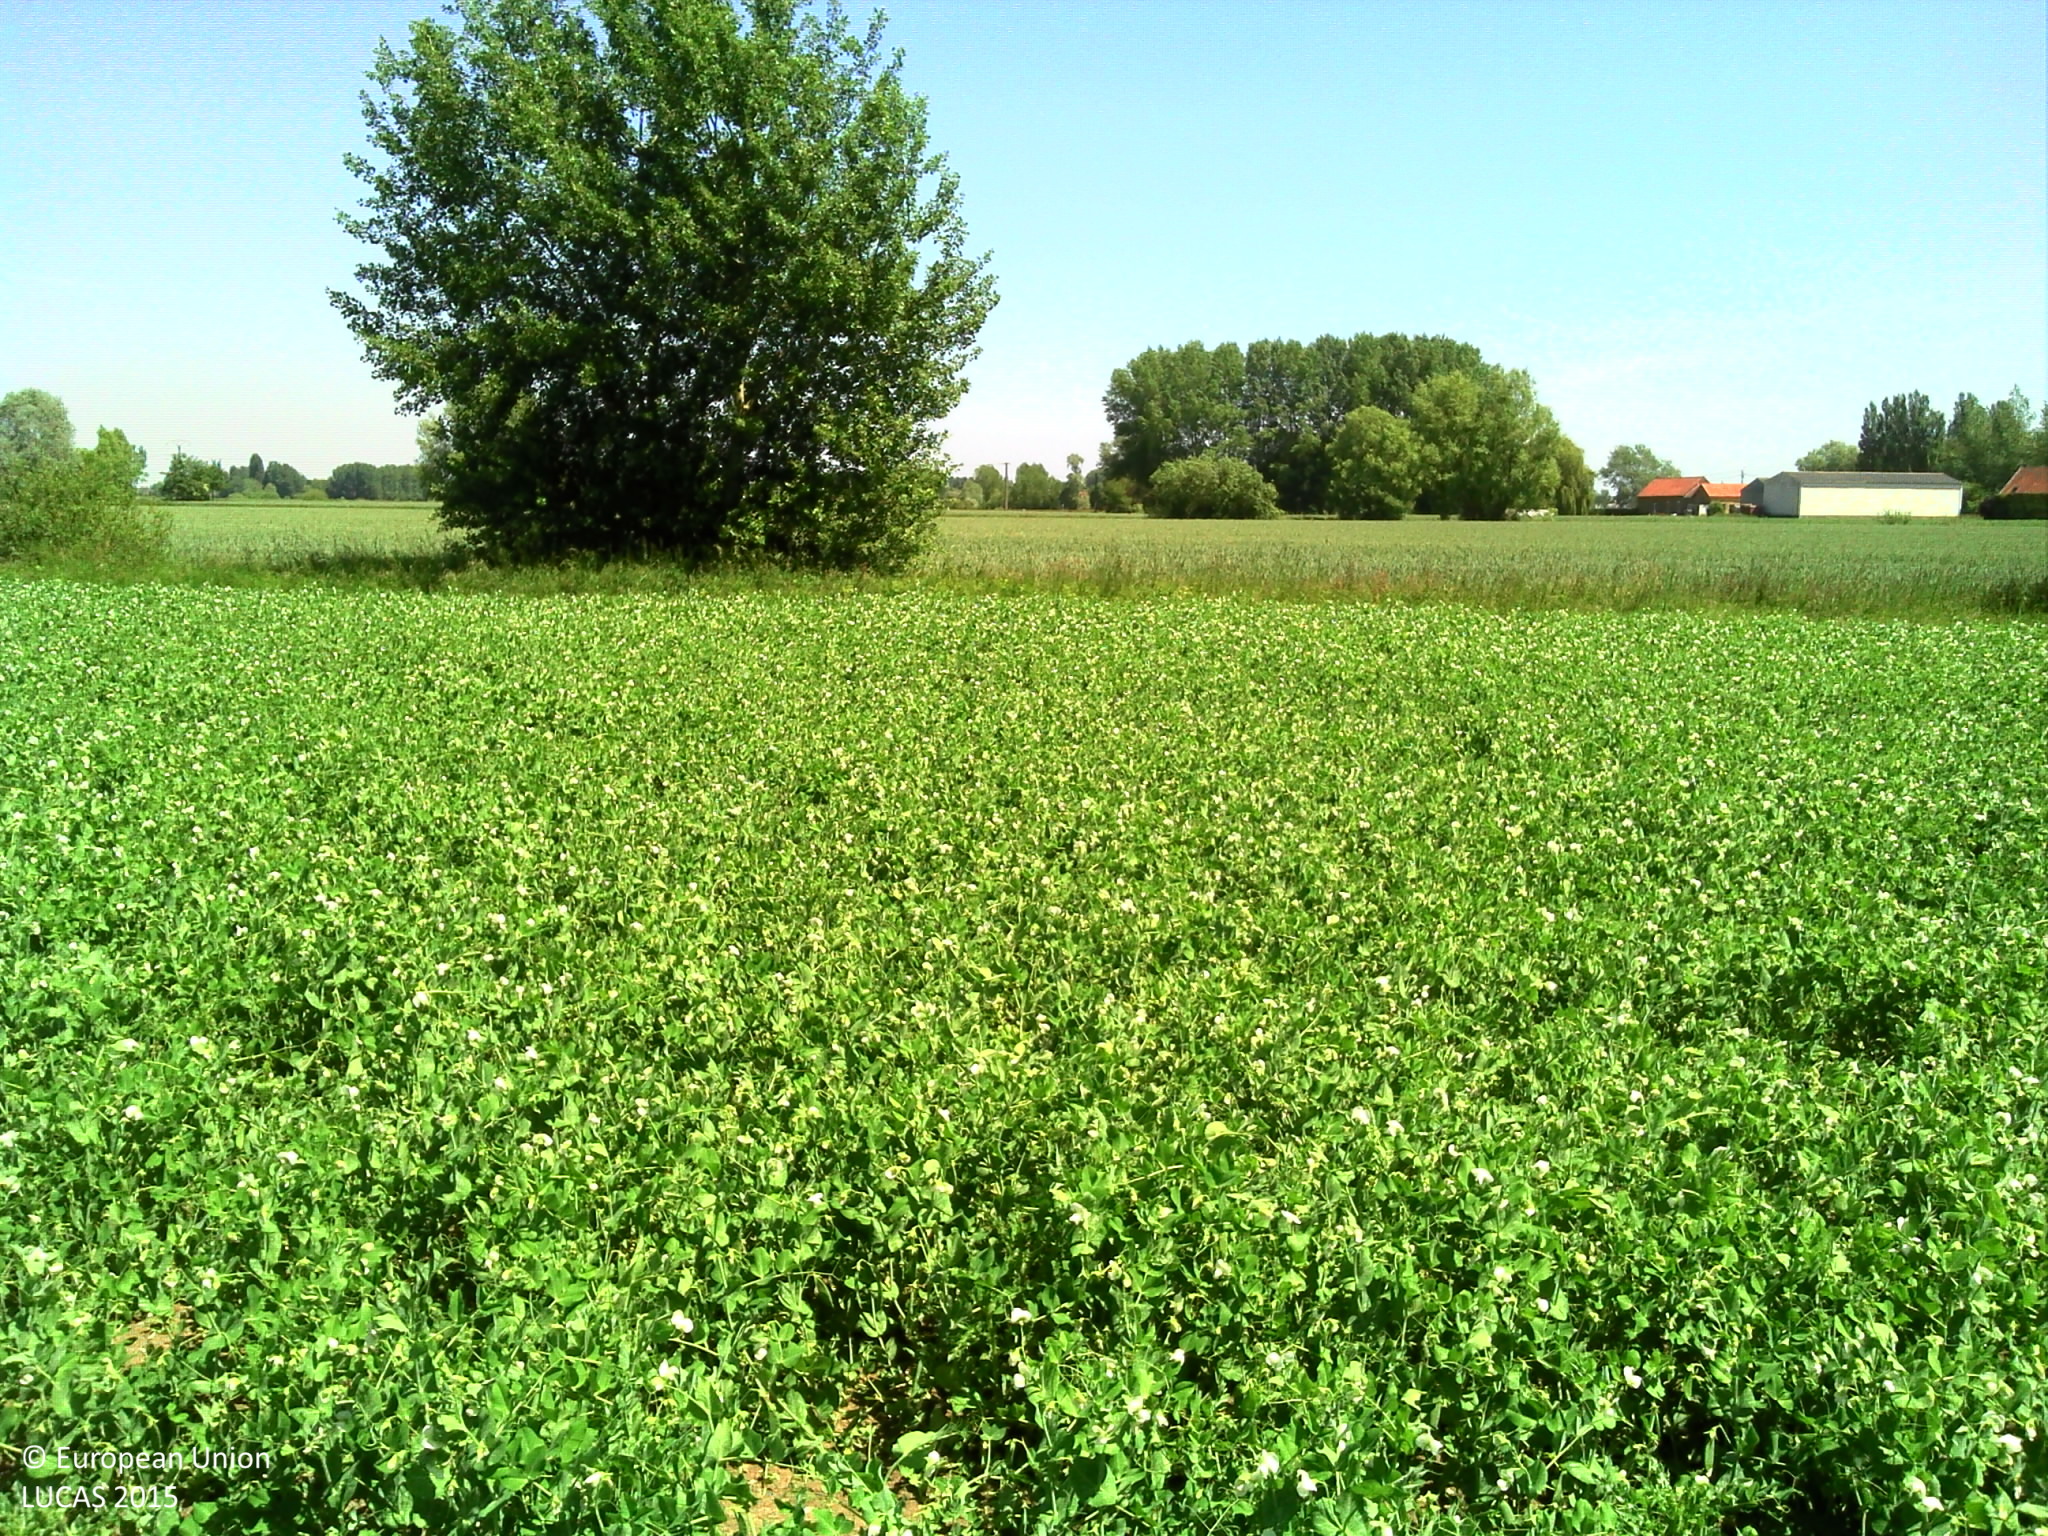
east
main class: Cropland
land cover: Other fresh vegetables
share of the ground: > 75 %
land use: Agriculture (excluding fallow land and kitchen gardens)
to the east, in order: Other fresh vegetables; Grass margins; Ditches and canals; Grass margins; Durum wheat; Grass margins; Ditches and canals; Single bushes/trees; Grass margins; Sugar beet; Grass margins; Ditches and canals; Grass margins; Durum wheat
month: June
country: FR
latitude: 50.5490
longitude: 2.7487
